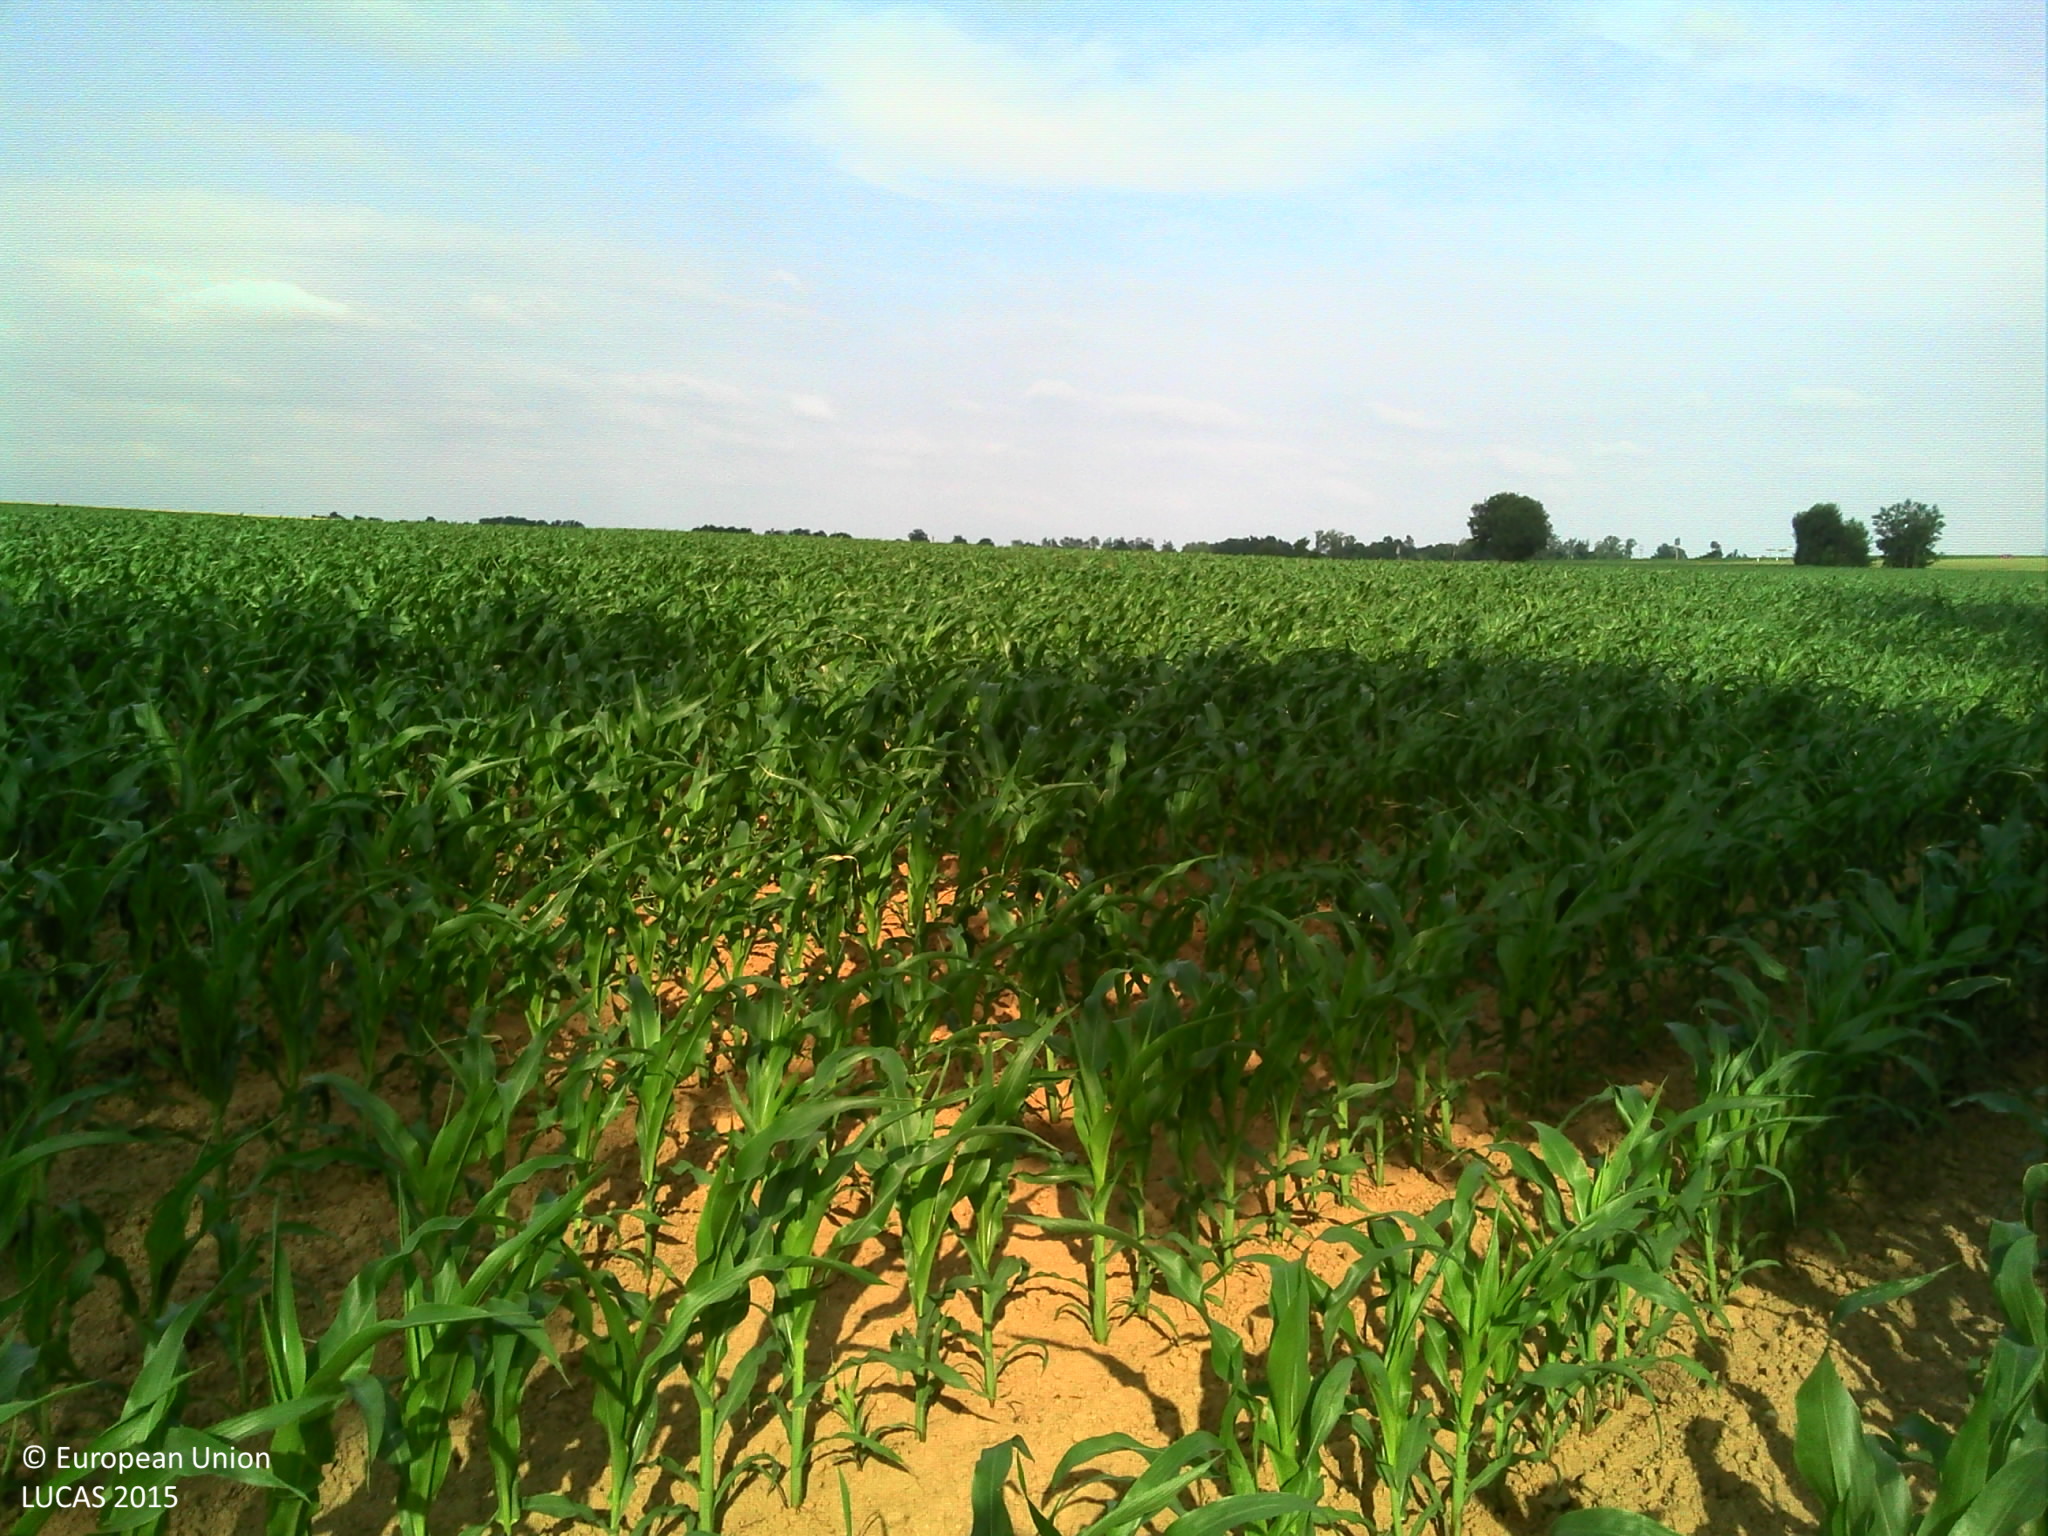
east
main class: Cropland
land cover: Maize
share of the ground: 25 - 50 %
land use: Agriculture (excluding fallow land and kitchen gardens)
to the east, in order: Maize; Lines of trees; Ditches and canals; Spontaneously vegetated surfaces; Maize
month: June
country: FR
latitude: 46.0453
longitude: 4.8208
